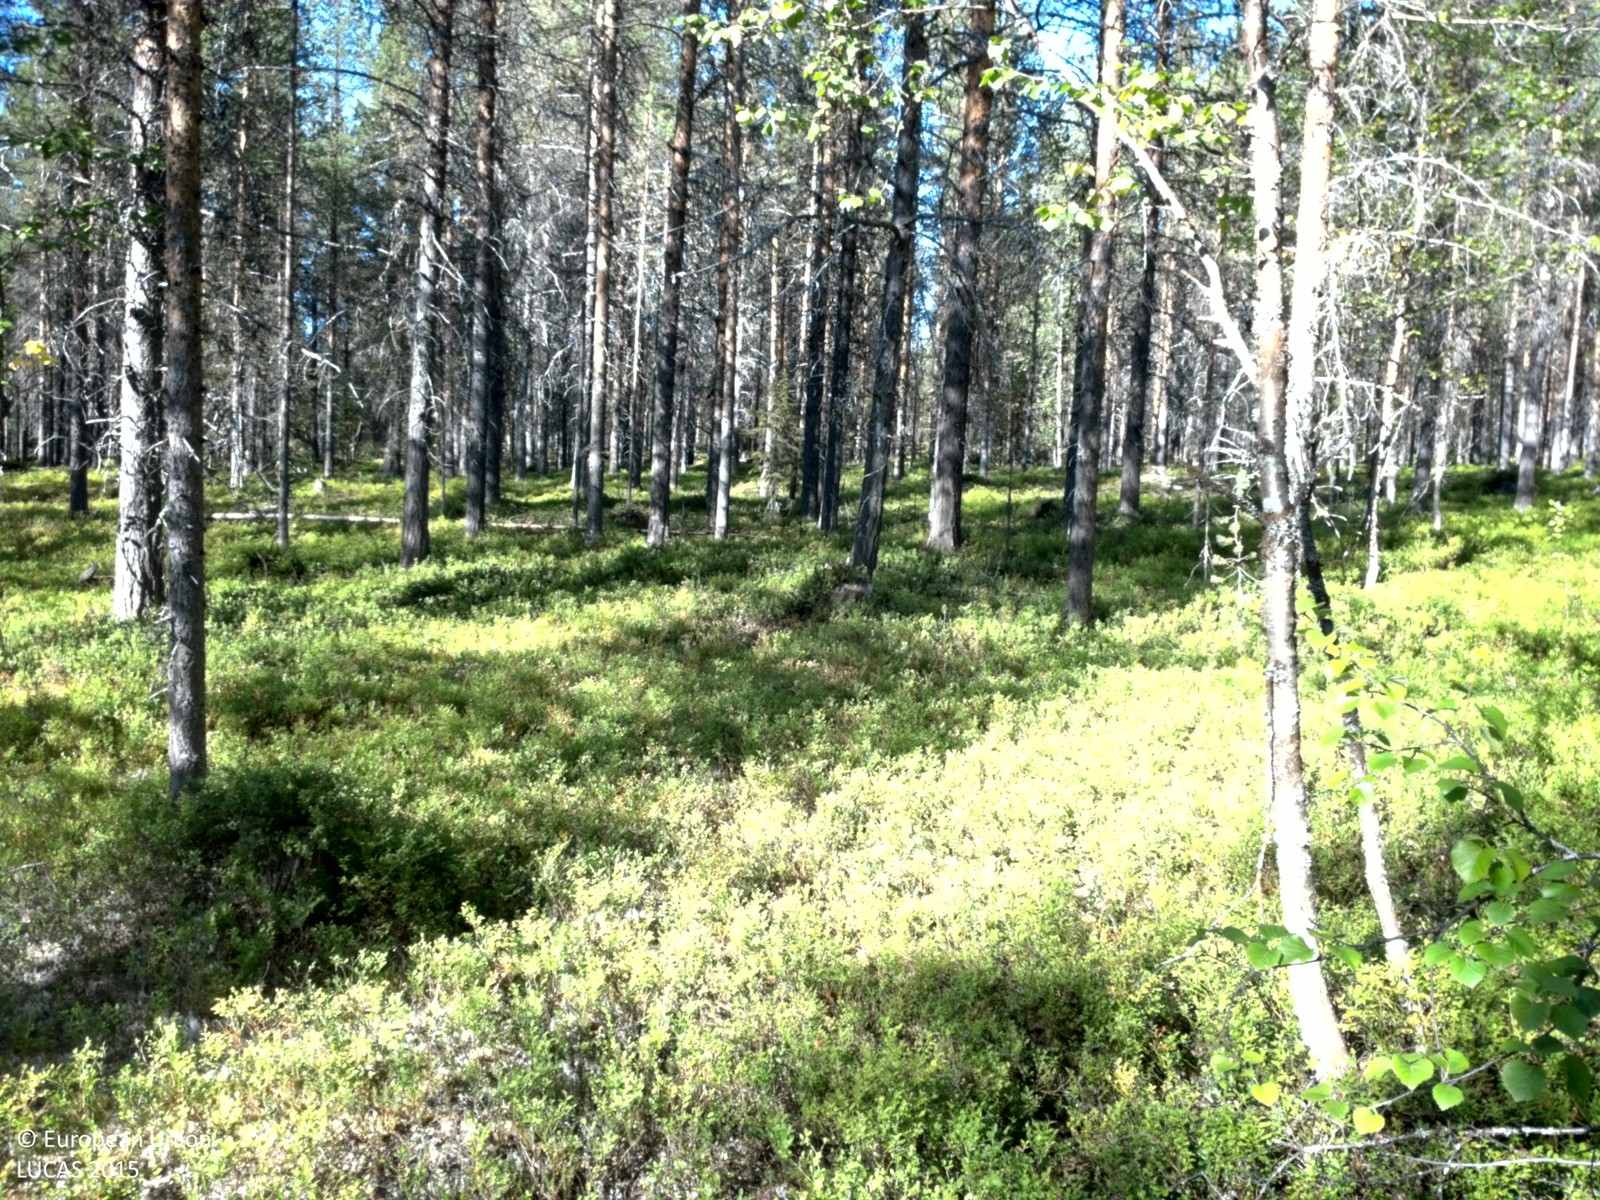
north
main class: Woodland
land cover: Pine dominated coniferous woodland
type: boreal forest
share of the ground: 25 - 50 %
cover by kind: shrubs 60 %, coniferous forest trees 40 %
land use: Forestry
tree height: > 5 m
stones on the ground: 10 - 25 %
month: August
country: SE
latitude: 66.6241
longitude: 18.9170
